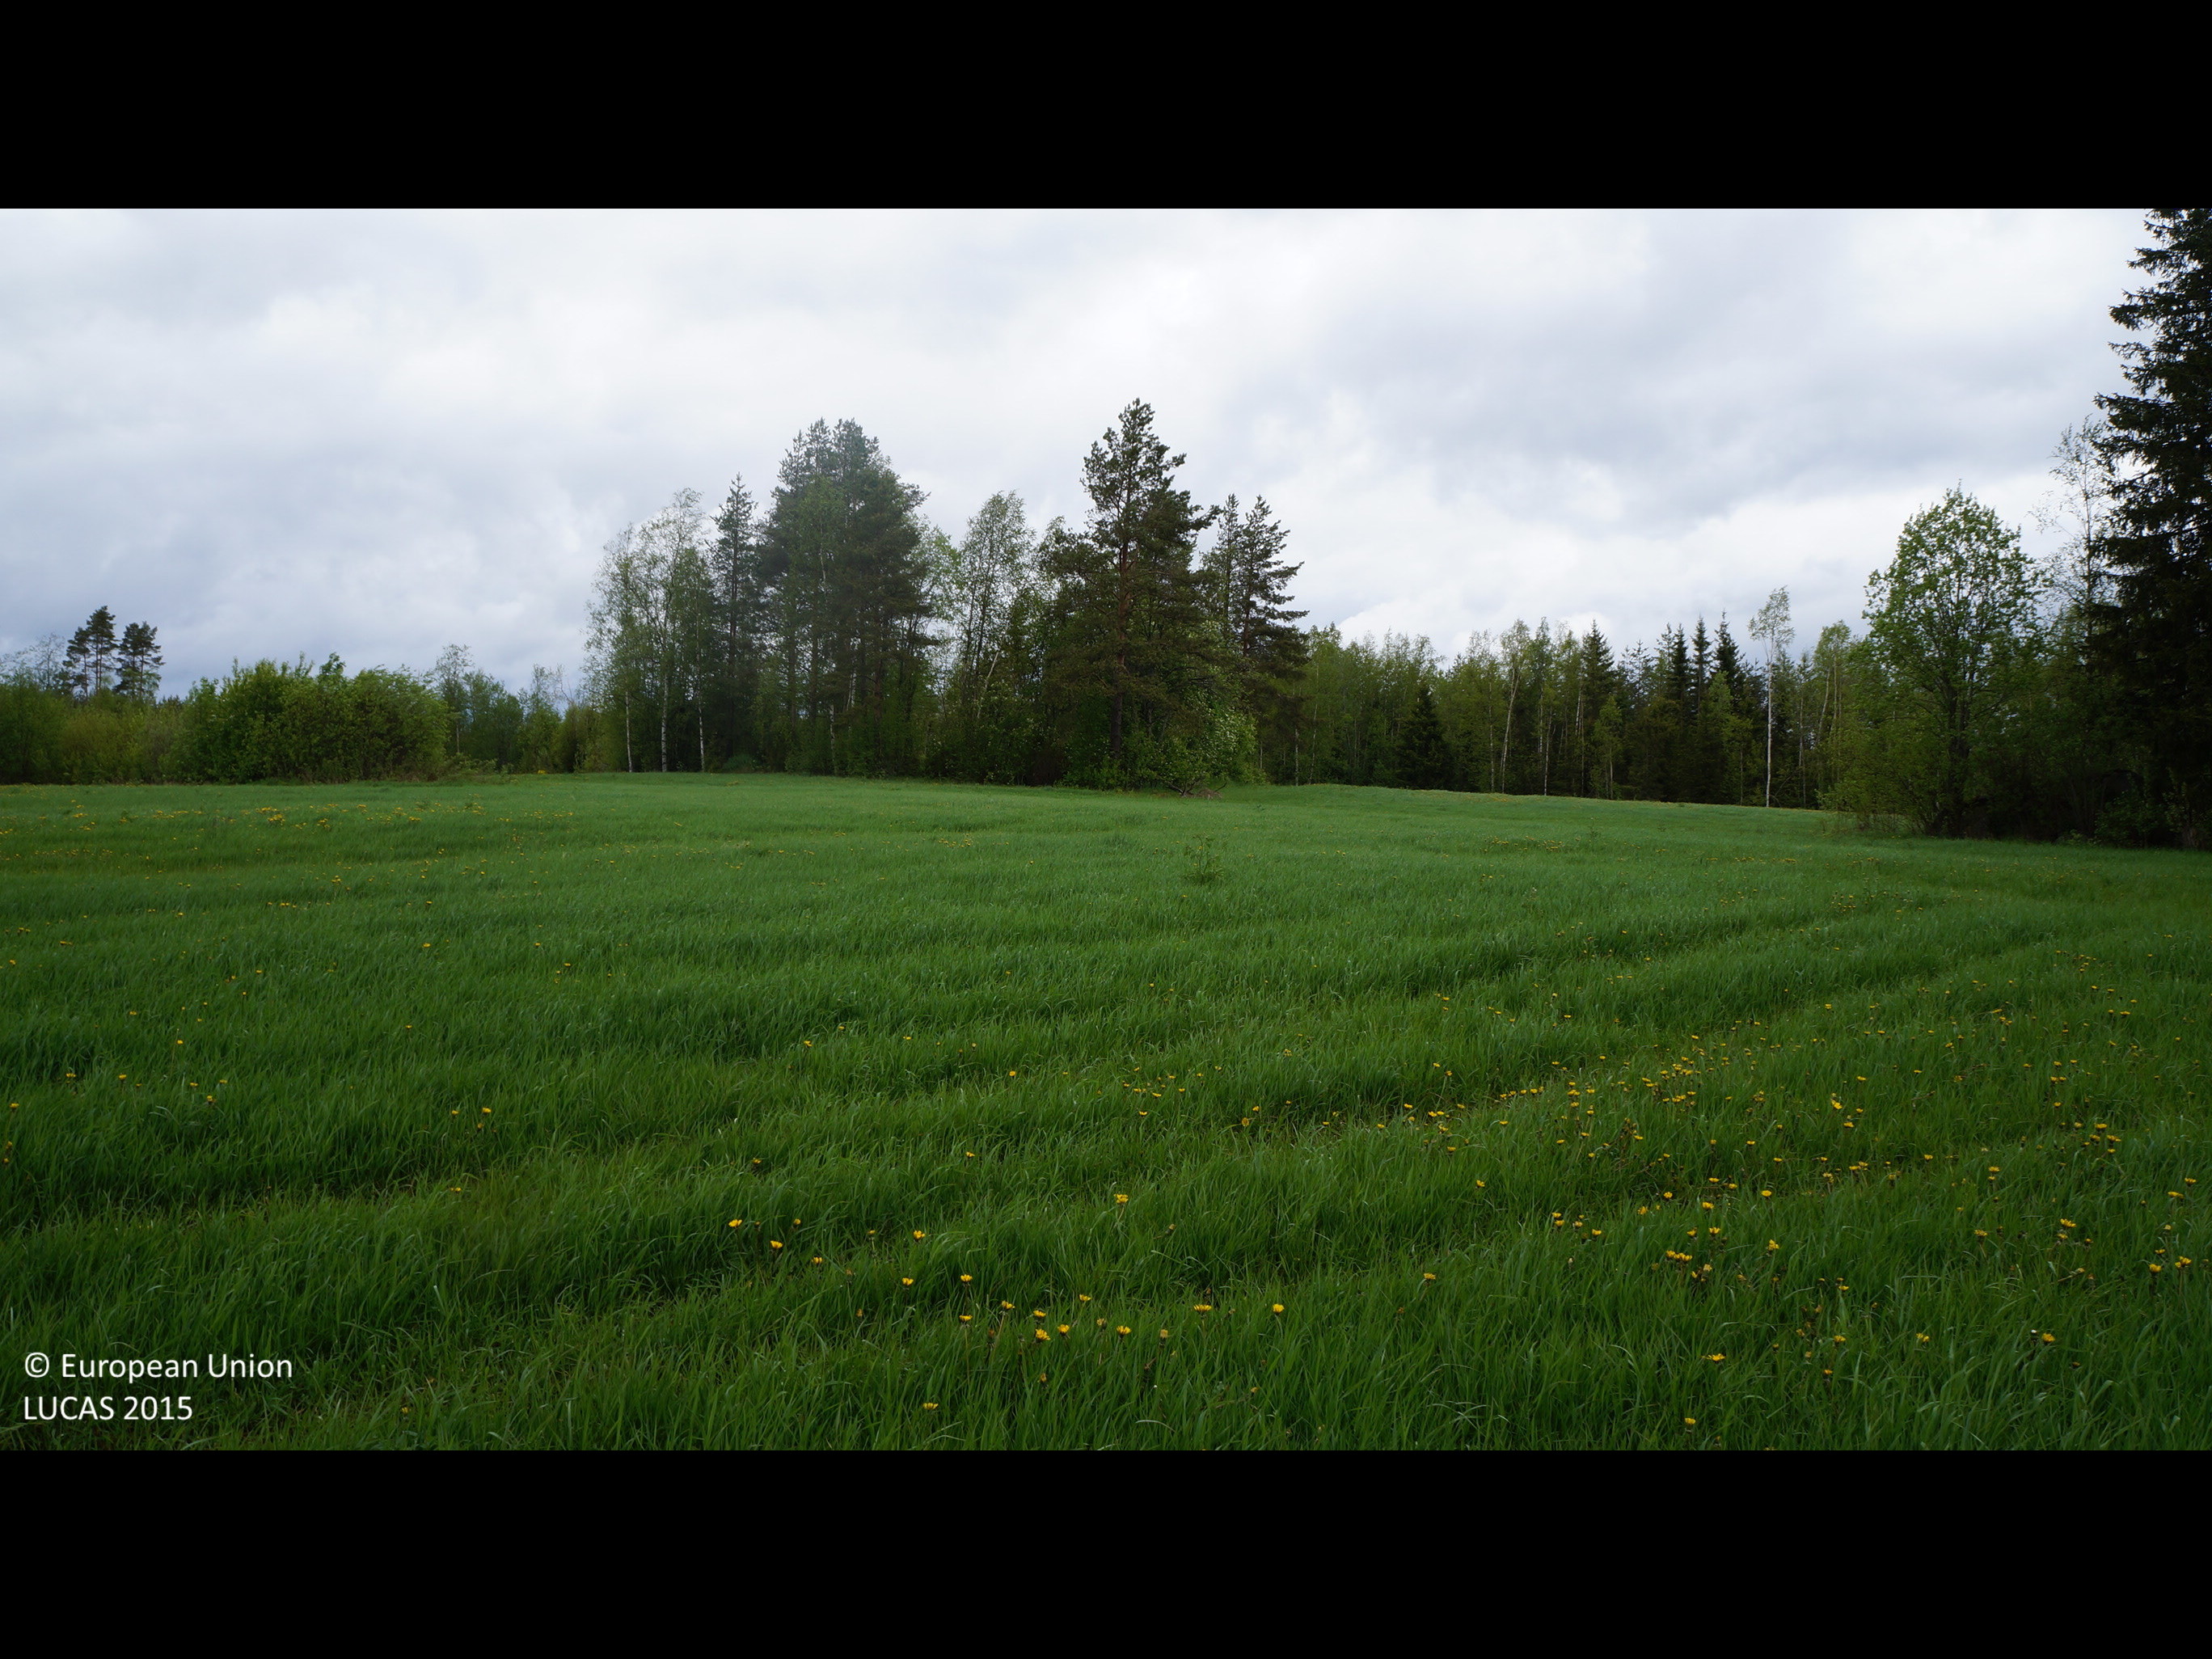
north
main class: Cropland
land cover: Temporary grasslands
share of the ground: > 75 %
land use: Agriculture (excluding fallow land and kitchen gardens)
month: June
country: FI
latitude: 63.8119
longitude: 23.3594
